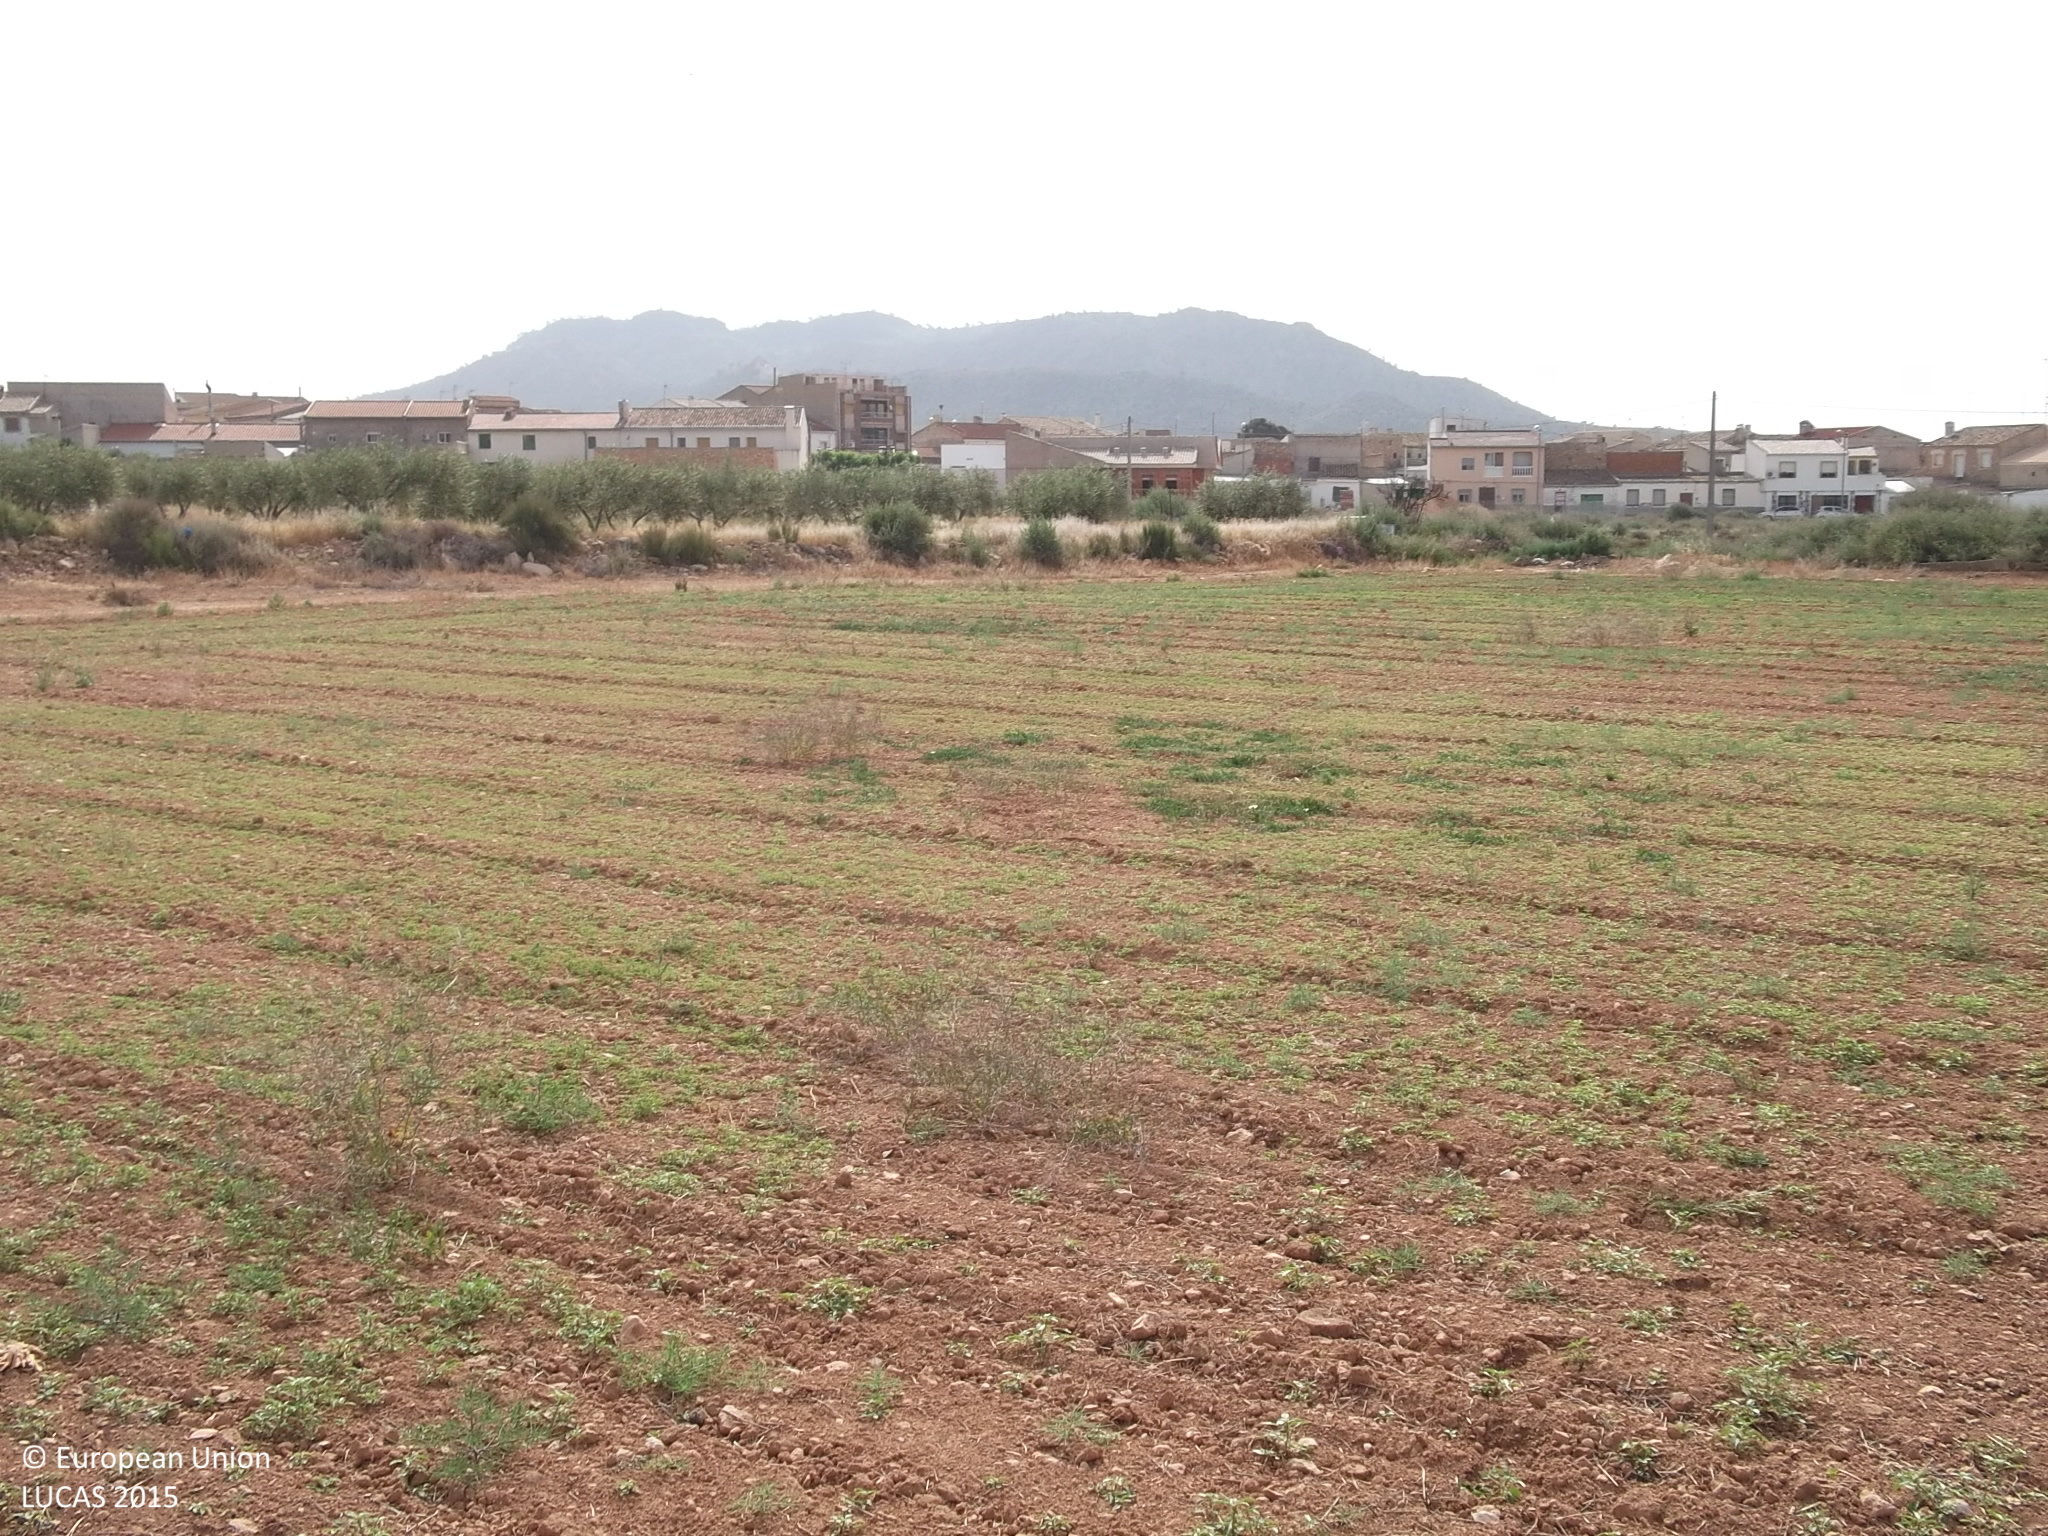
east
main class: Grassland
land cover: Spontaneously vegetated surfaces
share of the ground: 25 - 50 %
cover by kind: unconsolidated bare surface 70 %, herbaceous plants 30 %
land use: Fallow land
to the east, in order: Spontaneously vegetated surfaces; Tracks; Grass margins; Olive groves; Shrubland without tree cover; Electric lines; Shrubland without tree cover; Tracks; Shrubland without tree cover; Fences; Artificial constructions in urban areas
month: May
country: ES
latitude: 38.4206
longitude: -1.6404
